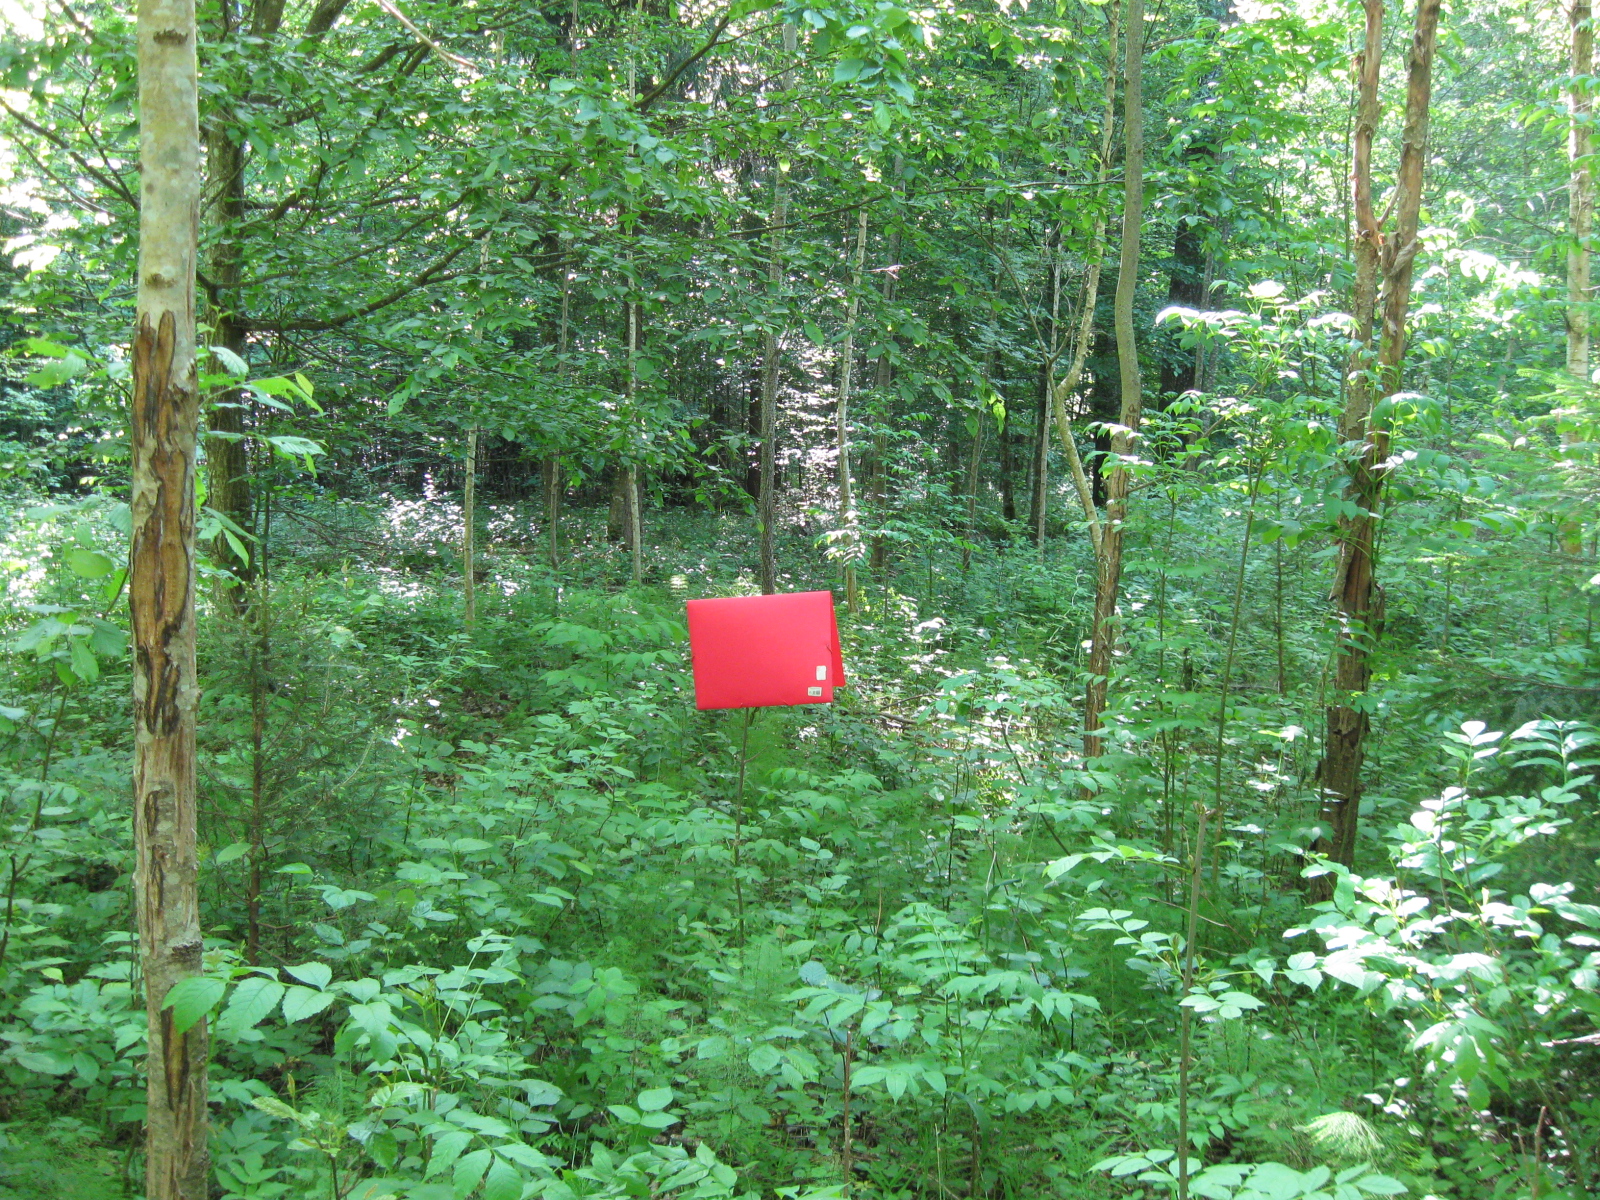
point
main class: Woodland
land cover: Spruce dominated mixed woodland
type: hemiboreal forest and nemoral coniferous forest and mixed broadleaved-coniferous forest
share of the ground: > 75 %
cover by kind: broadleaved forest trees 70 %, coniferous forest trees 30 %
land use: Forestry
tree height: > 5 m
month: June
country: LT
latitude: 54.5281
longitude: 23.7621
